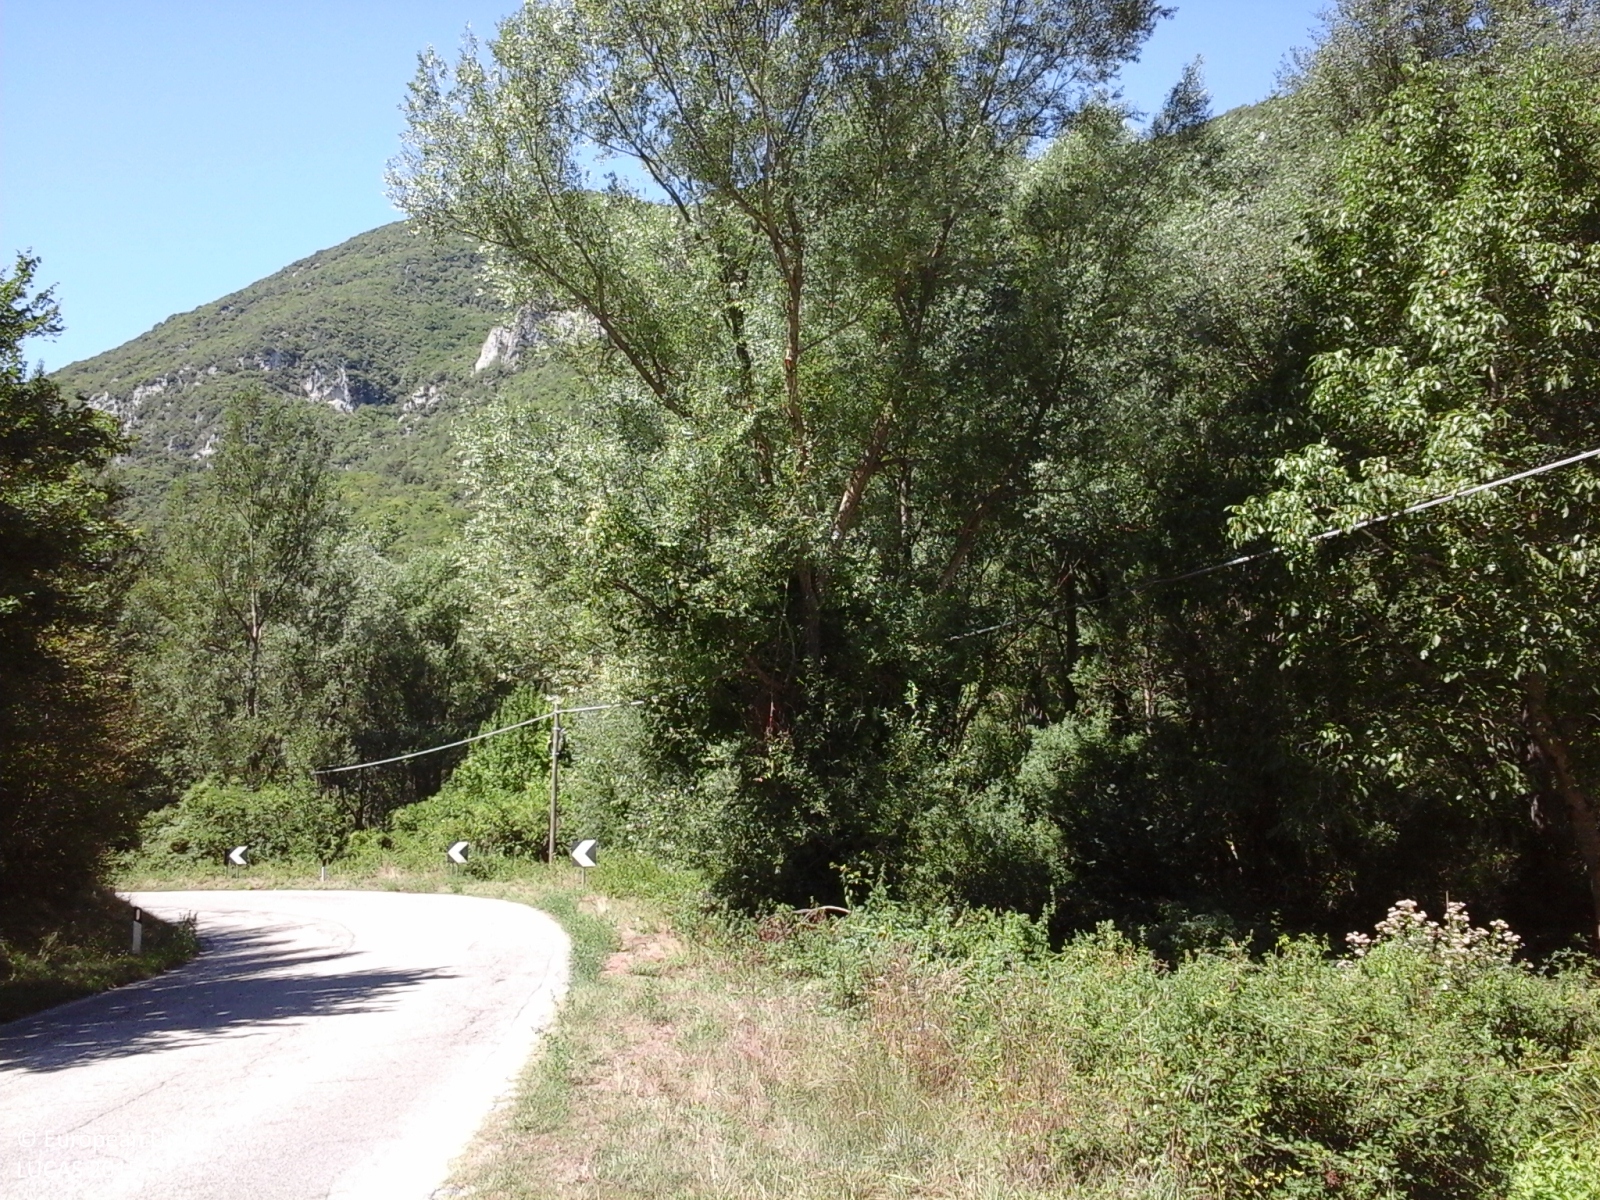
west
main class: Woodland
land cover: Broadleaved woodland
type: thermophilous deciduous forest
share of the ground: > 75 %
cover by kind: broadleaved forest trees 95 %, coniferous forest trees 5 %
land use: Forestry
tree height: > 5 m
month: August
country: IT
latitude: 43.1703
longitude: 12.9809
